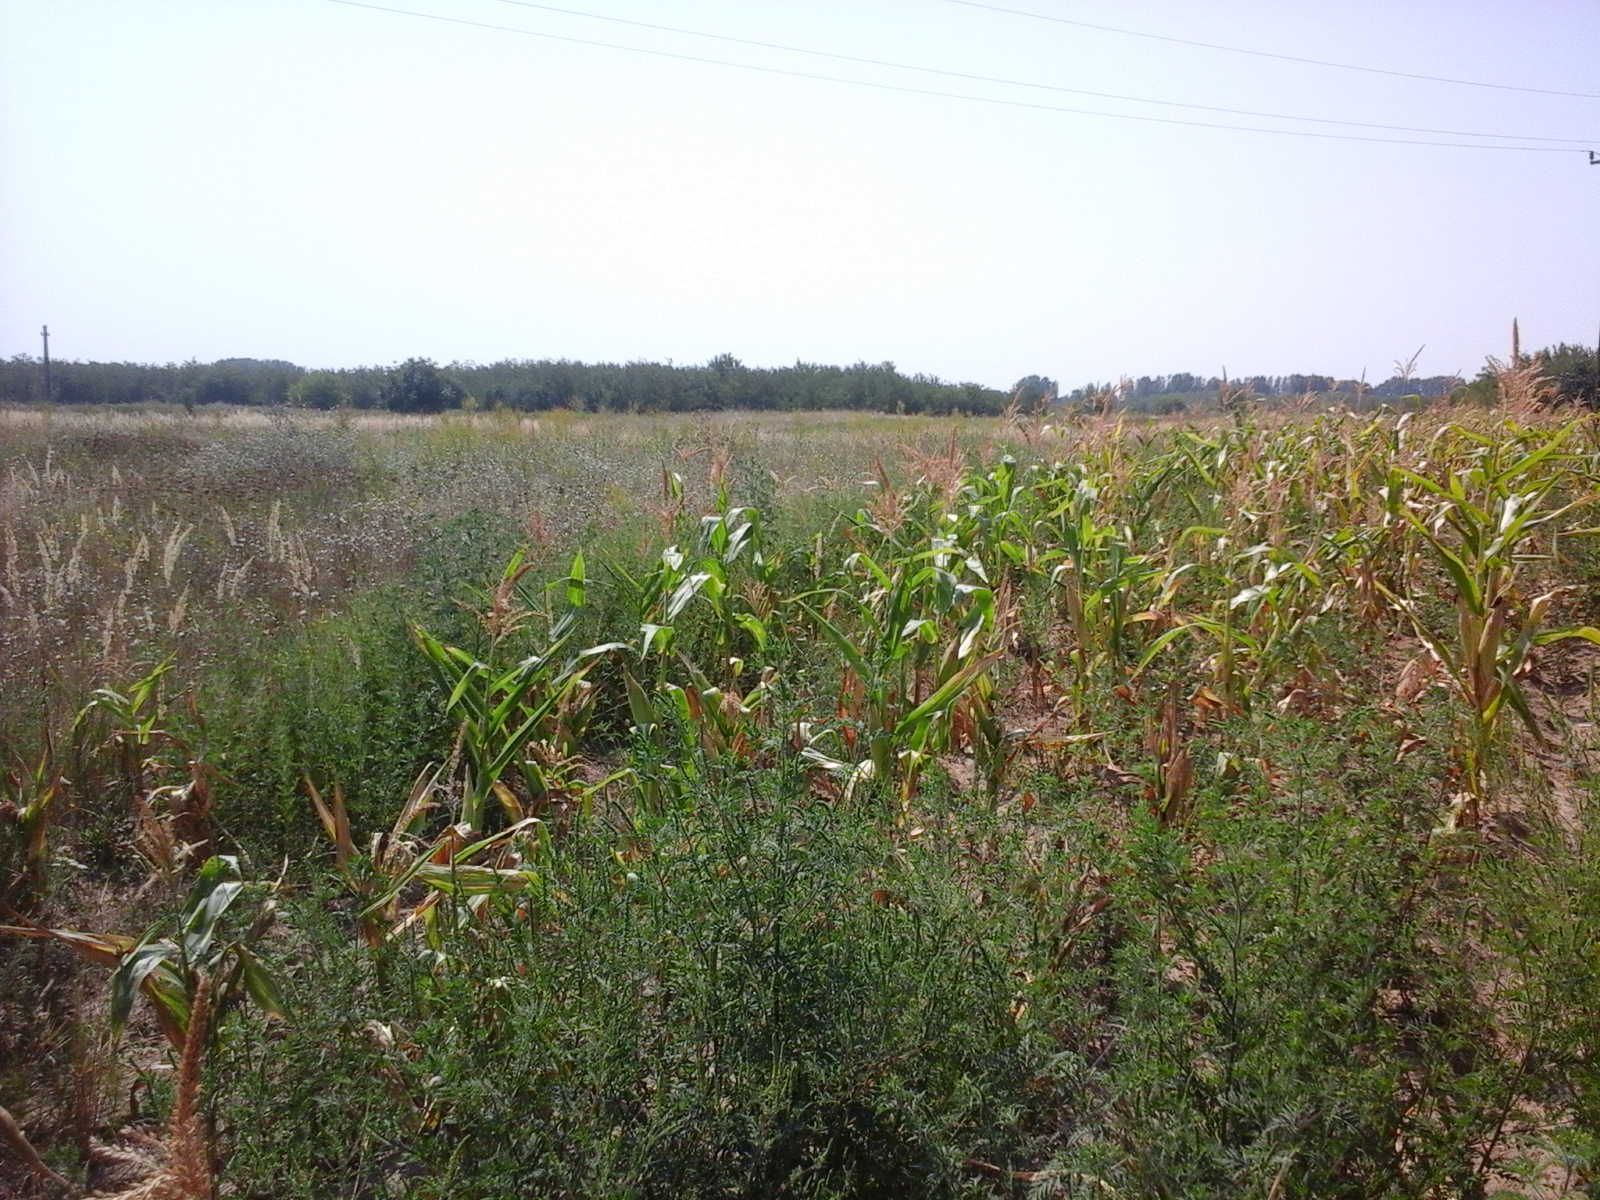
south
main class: Cropland
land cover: Maize
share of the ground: > 75 %
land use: Agriculture (excluding fallow land and kitchen gardens)
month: August
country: RO
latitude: 44.4075
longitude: 22.6852
